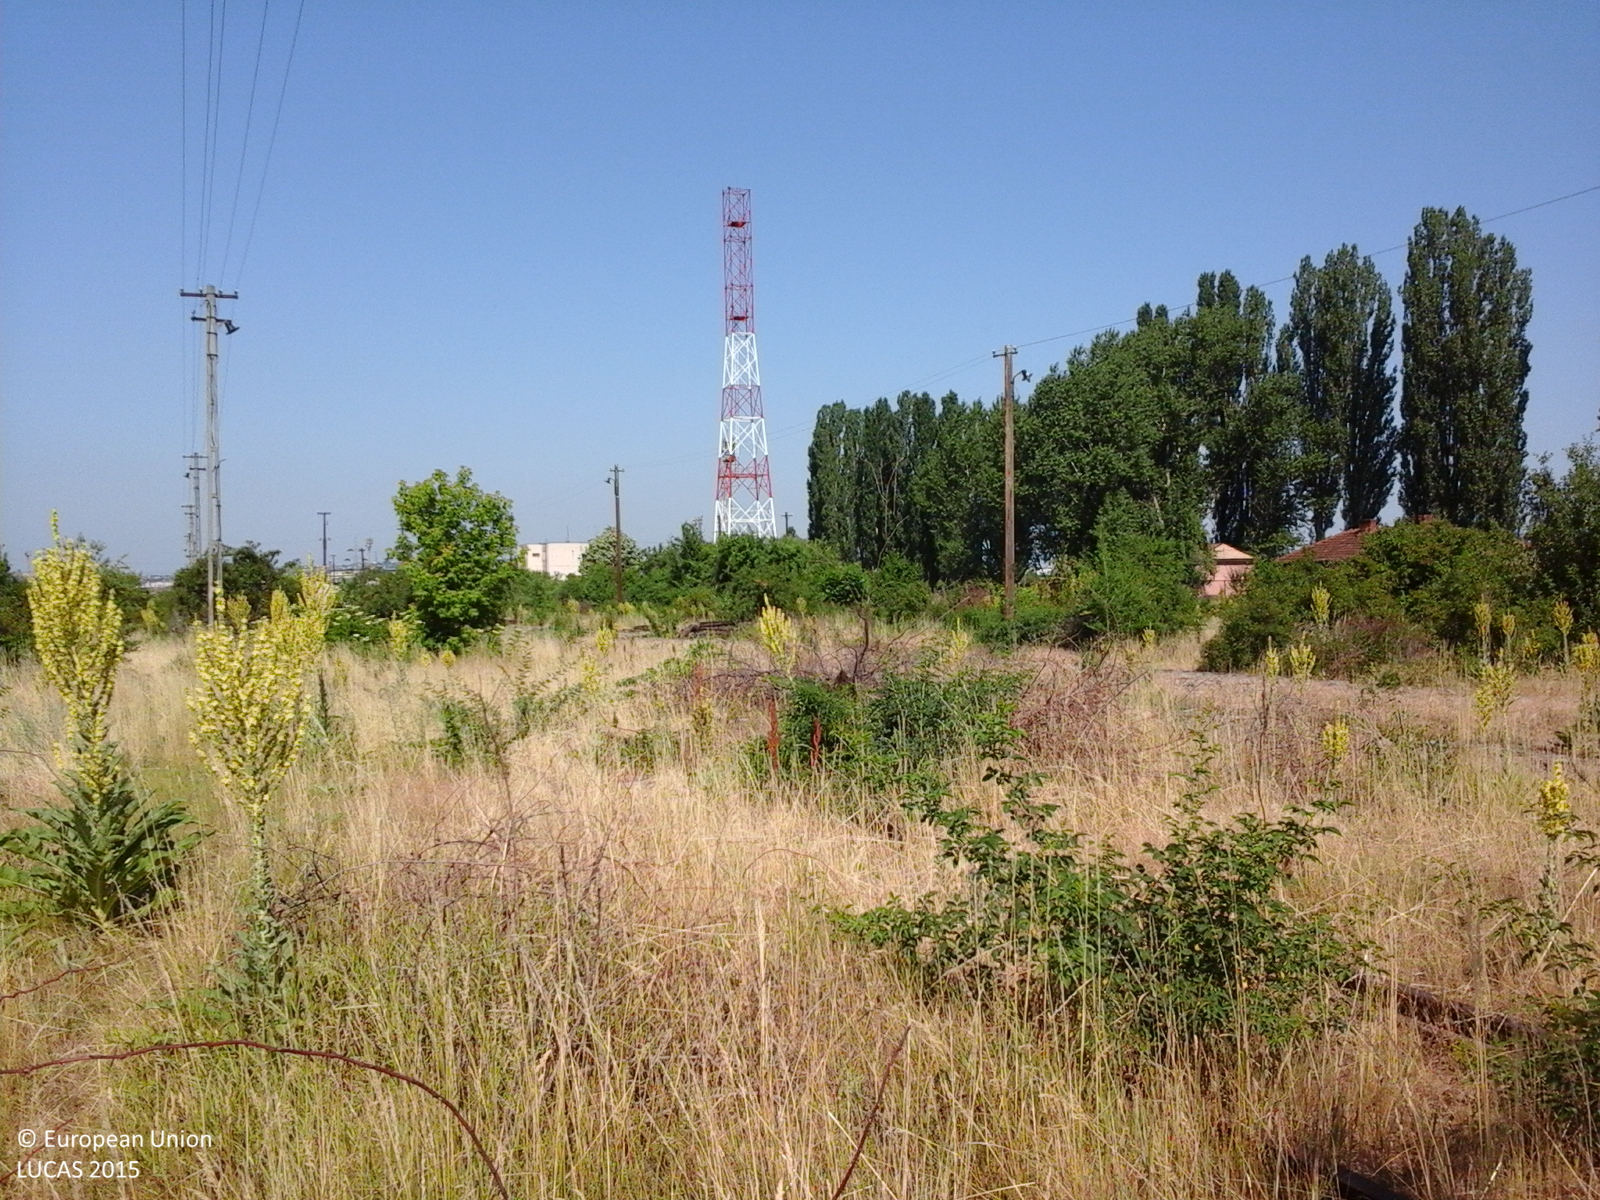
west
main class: Grassland
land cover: Grassland with sparse tree/shrub cover
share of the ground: 25 - 50 %
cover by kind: herbaceous plants 90 %, broadleaved forest trees 5 %, shrubs 5 %
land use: Railway transport
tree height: < 5 m
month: June
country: RO
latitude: 47.1396
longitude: 27.6164
